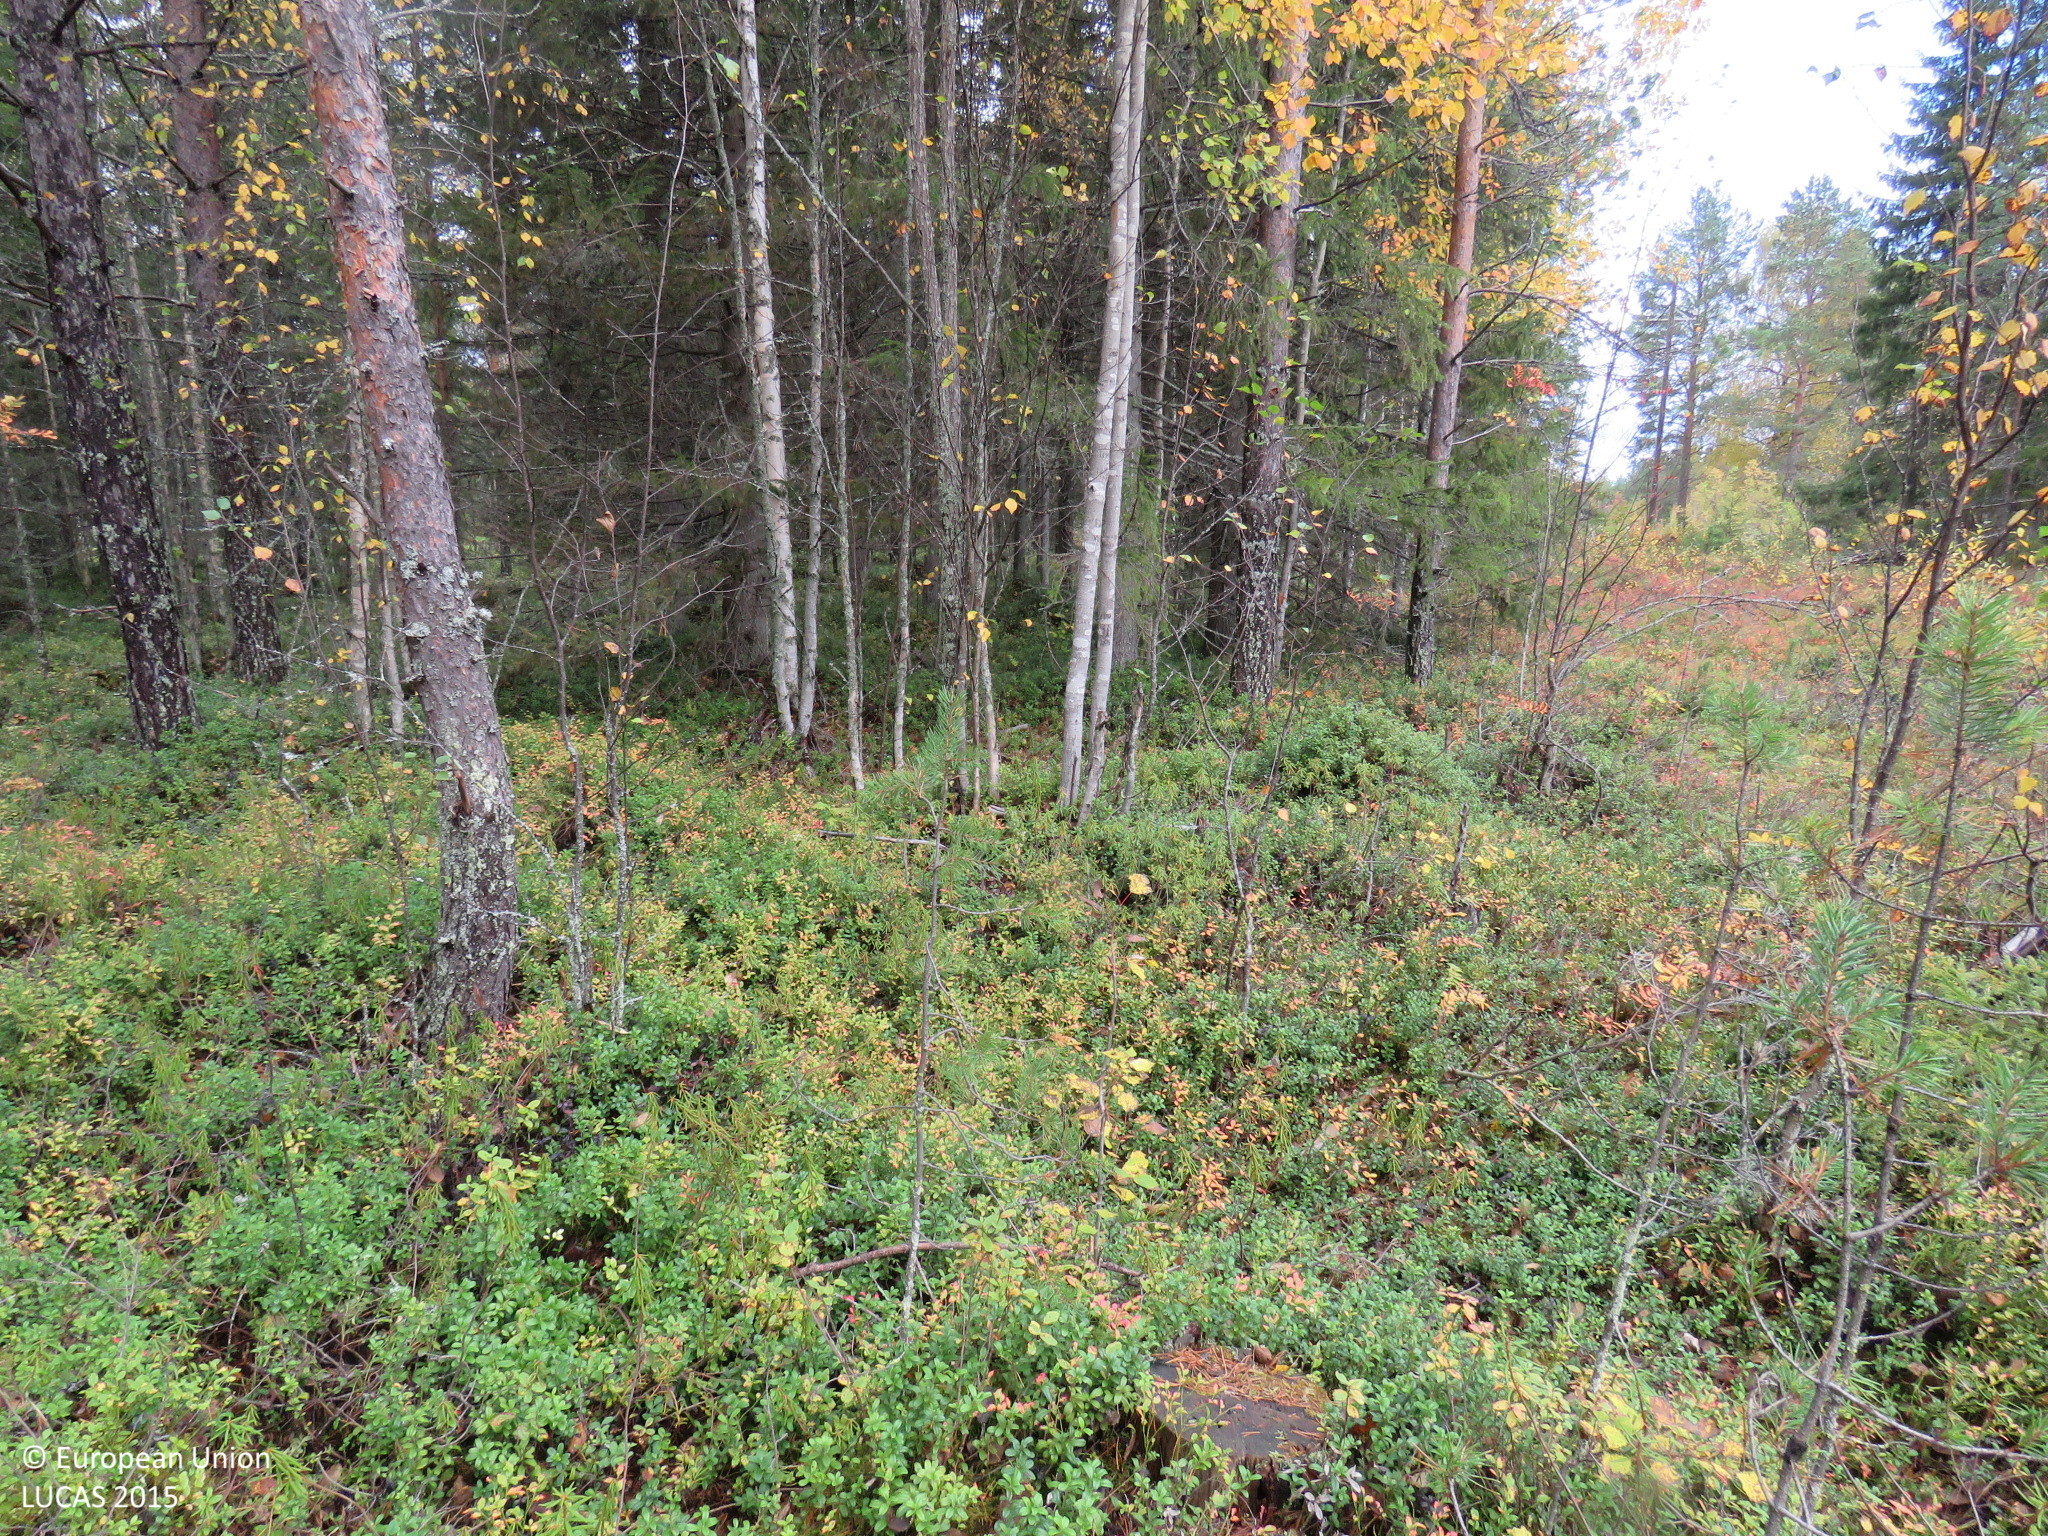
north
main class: Woodland
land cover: Pine dominated mixed woodland
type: boreal forest
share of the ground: > 75 %
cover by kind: broadleaved forest trees 45 %, coniferous forest trees 40 %, shrubs 15 %
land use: Forestry
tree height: > 5 m
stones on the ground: < 10 %
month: September
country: FI
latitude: 65.0660
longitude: 27.0224
